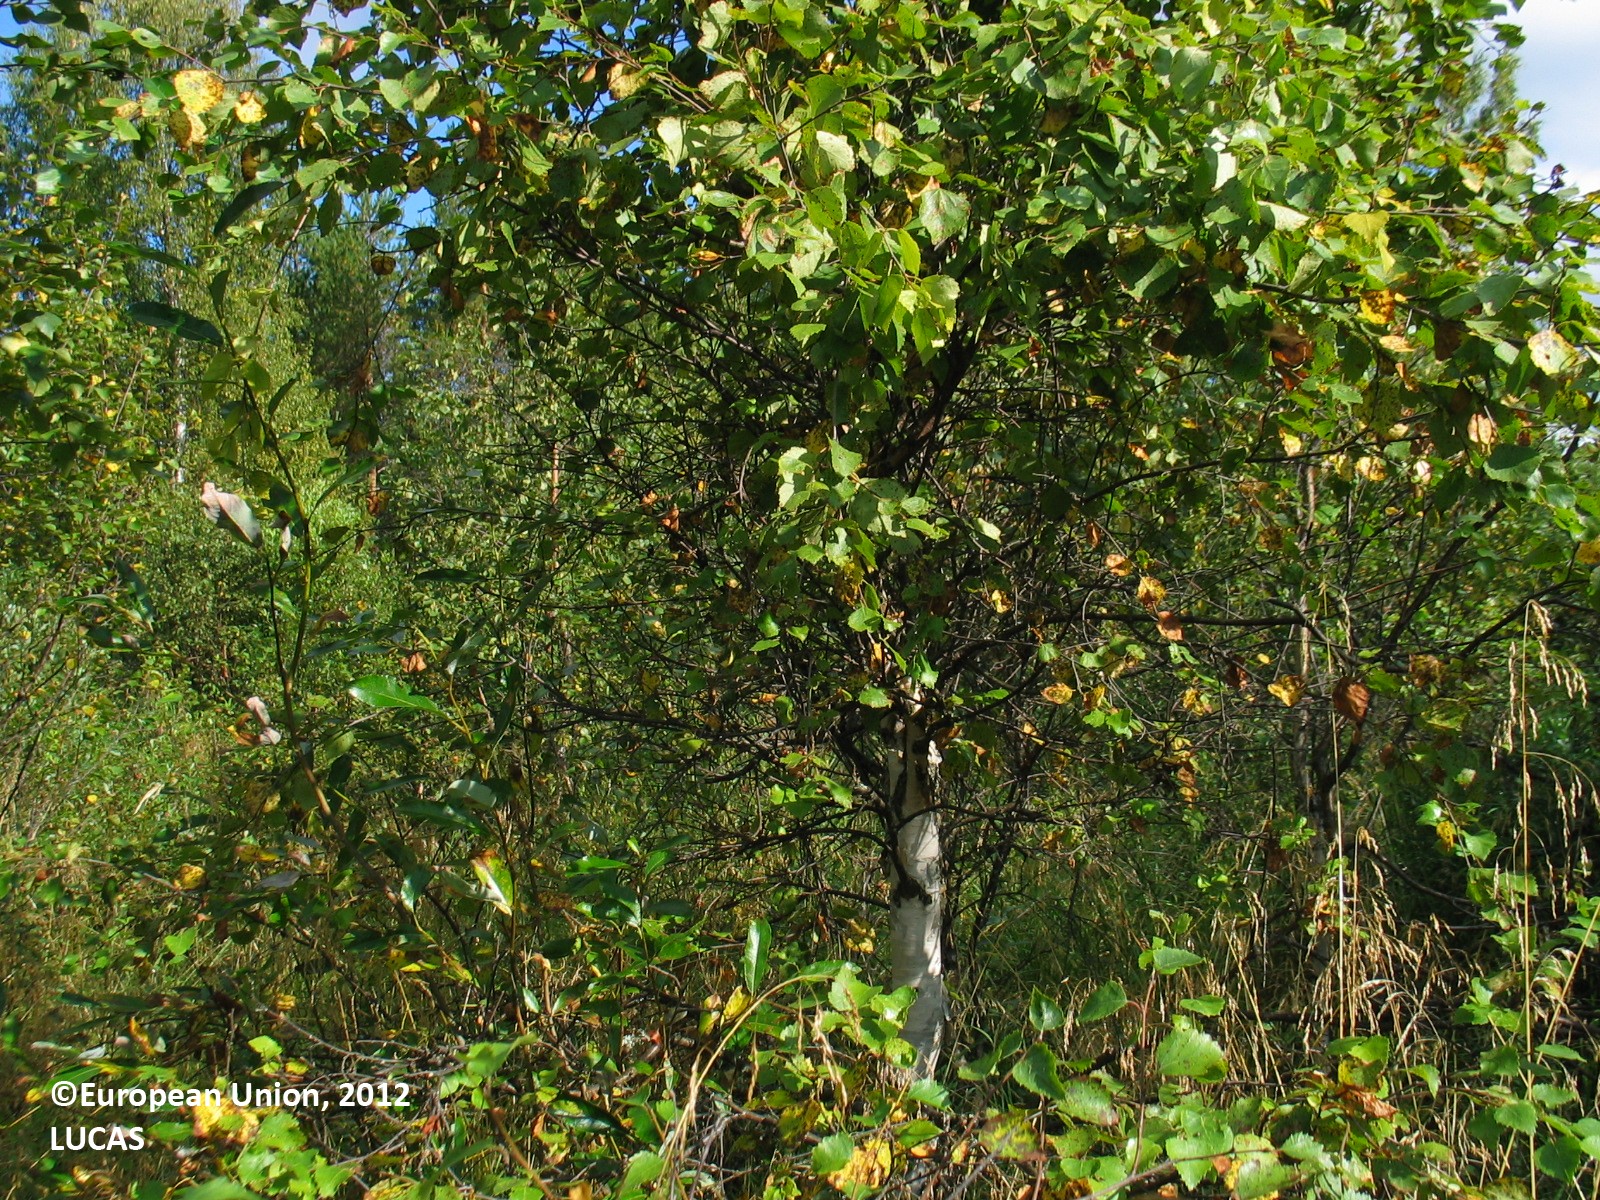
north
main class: Woodland
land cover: Broadleaved woodland
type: boreal forest
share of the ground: 25 - 50 %
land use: Forestry
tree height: > 5 m
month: August
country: FI
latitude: 65.5142
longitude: 26.4689
